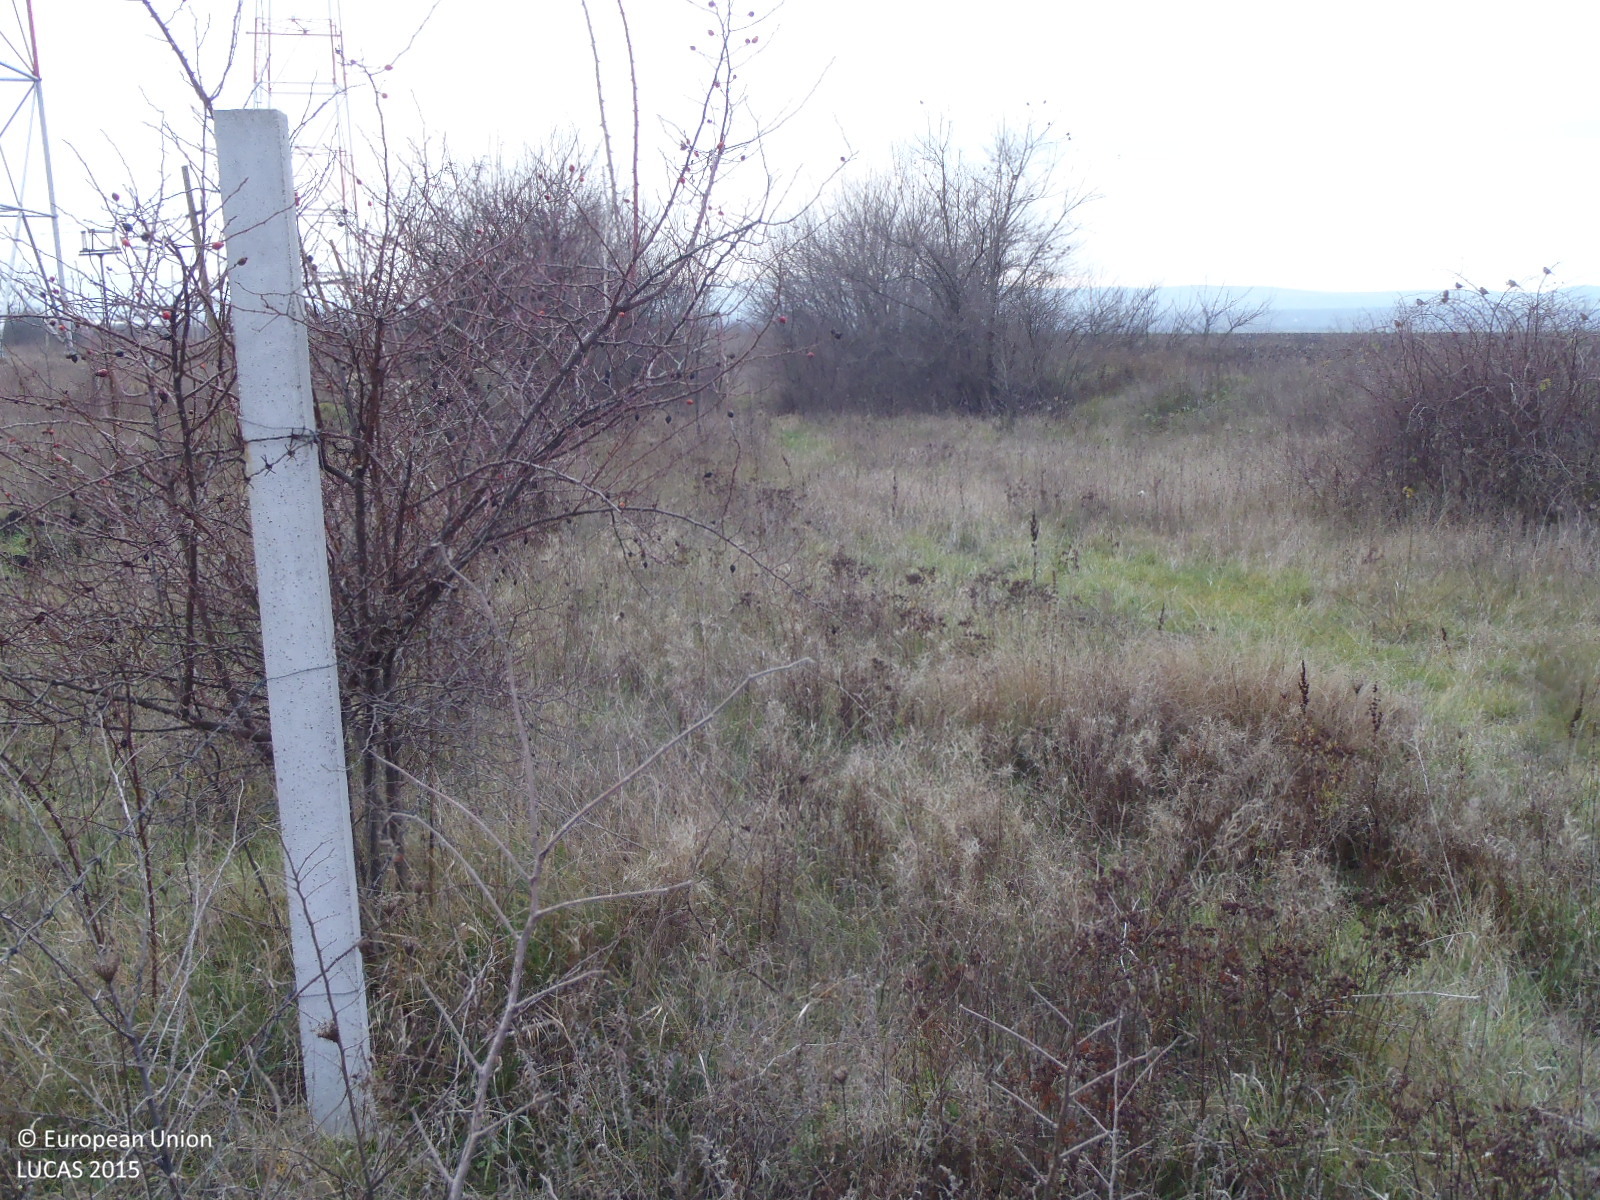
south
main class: Grassland
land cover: Grassland with sparse tree/shrub cover
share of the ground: > 75 %
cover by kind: herbaceous plants 85 %, shrubs 10 %, broadleaved forest trees 5 %
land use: Community services
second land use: Telecommunication
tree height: < 5 m
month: December
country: BG
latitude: 42.8118
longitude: 23.1800
